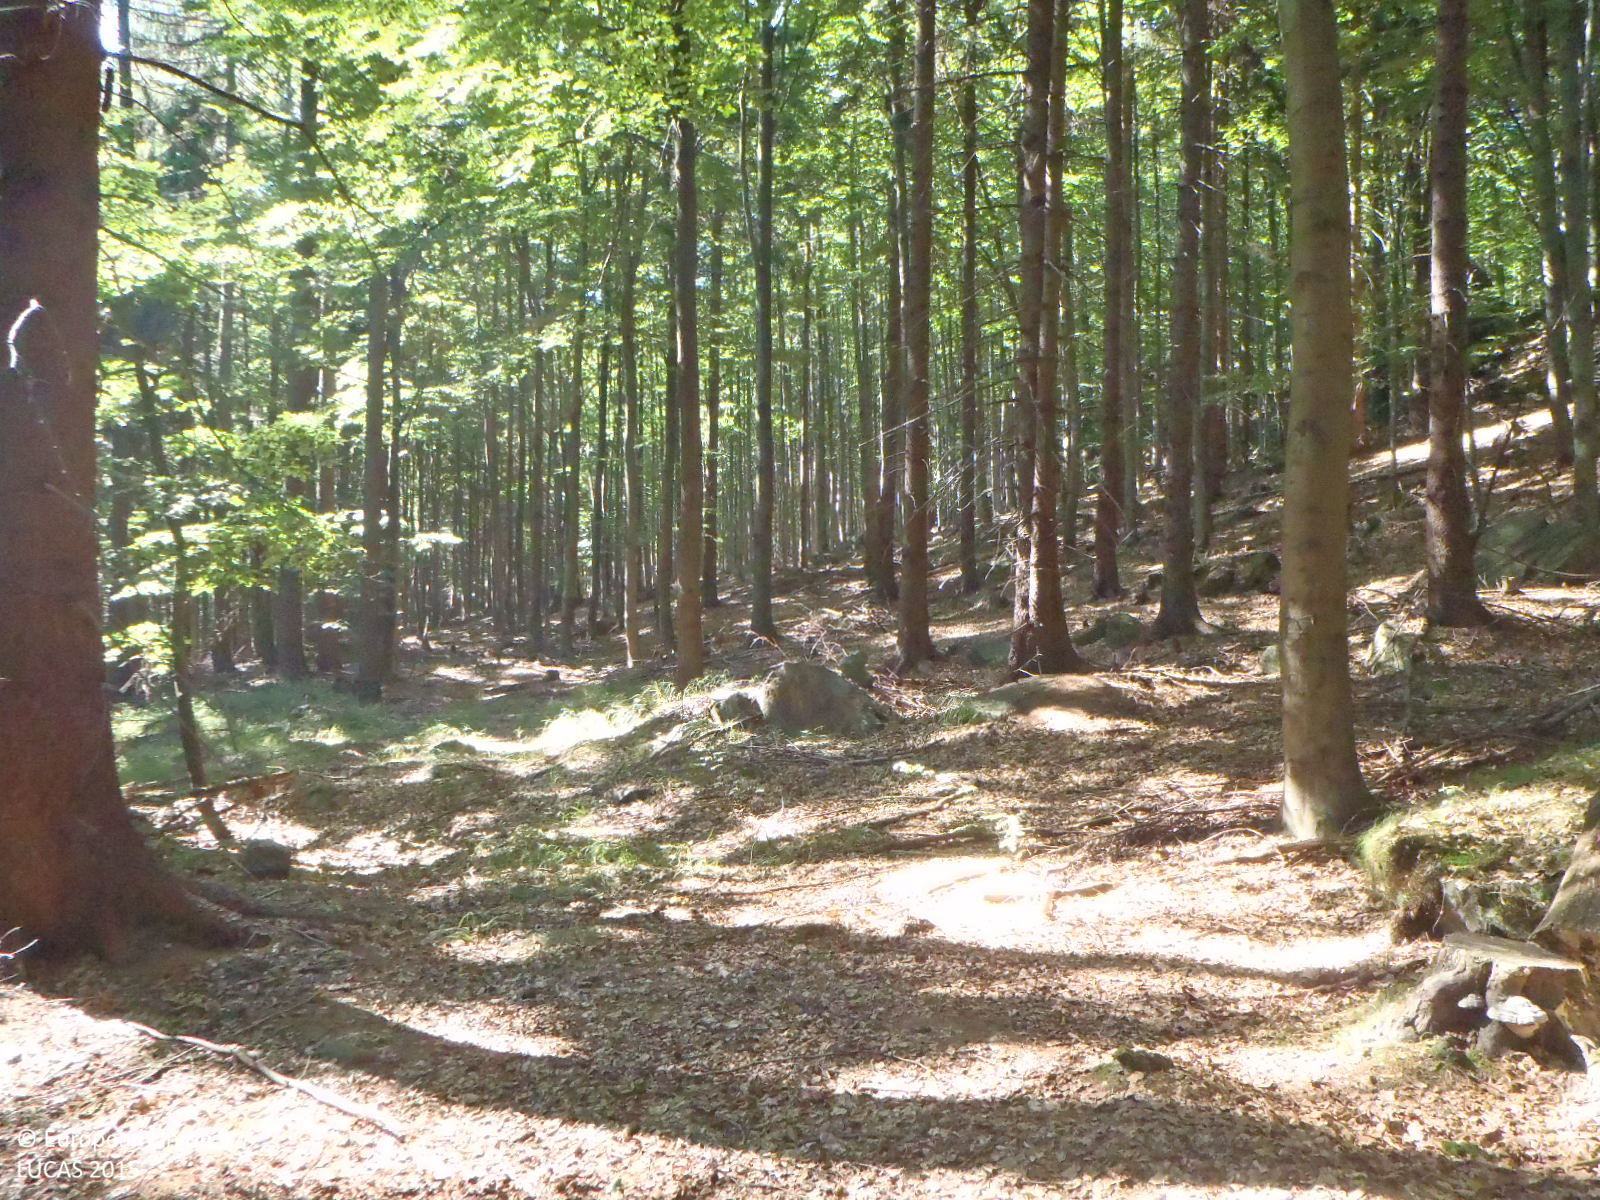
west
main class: Woodland
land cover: Other mixed woodland
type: hemiboreal forest and nemoral coniferous forest and mixed broadleaved-coniferous forest
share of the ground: > 75 %
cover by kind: broadleaved forest trees 60 %, coniferous forest trees 40 %
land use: Forestry
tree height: > 5 m
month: August
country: CZ
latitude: 50.8124
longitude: 14.5862
